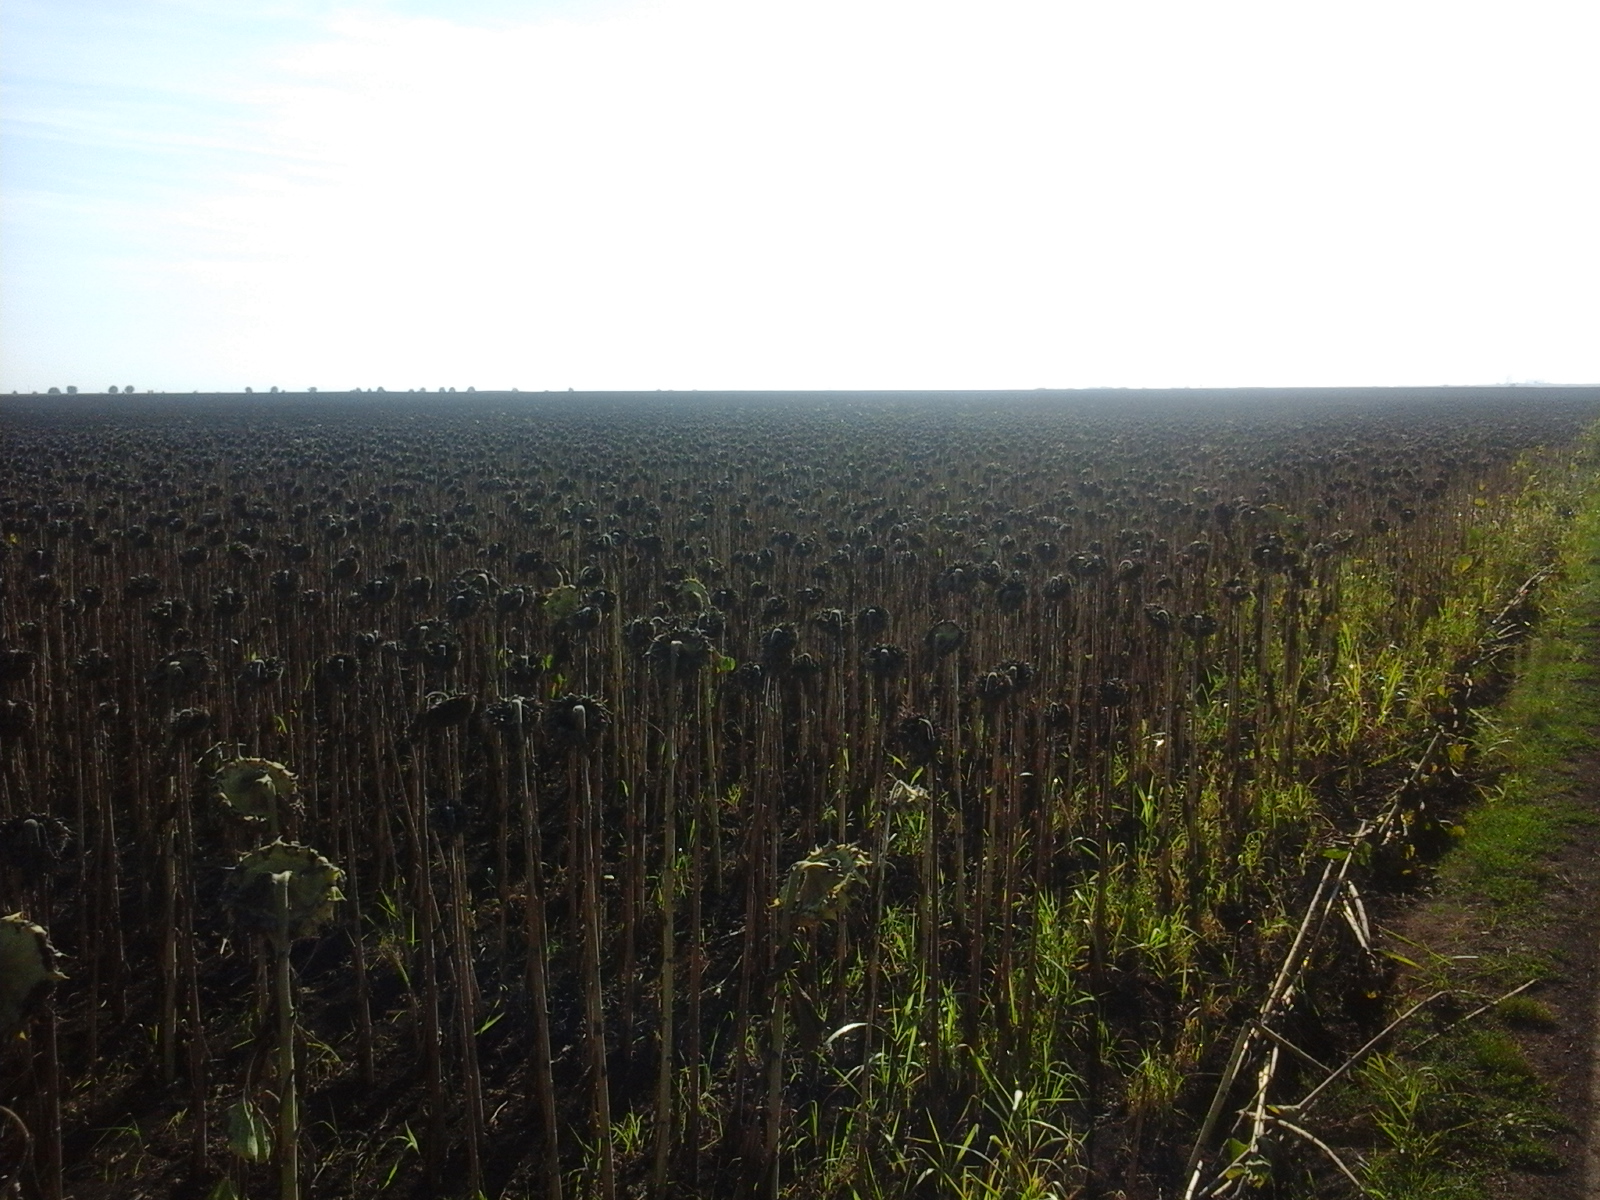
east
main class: Cropland
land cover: Sunflower
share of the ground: > 75 %
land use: Agriculture (excluding fallow land and kitchen gardens)
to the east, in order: Sunflower
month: August
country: RO
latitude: 46.0258
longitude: 21.1017
